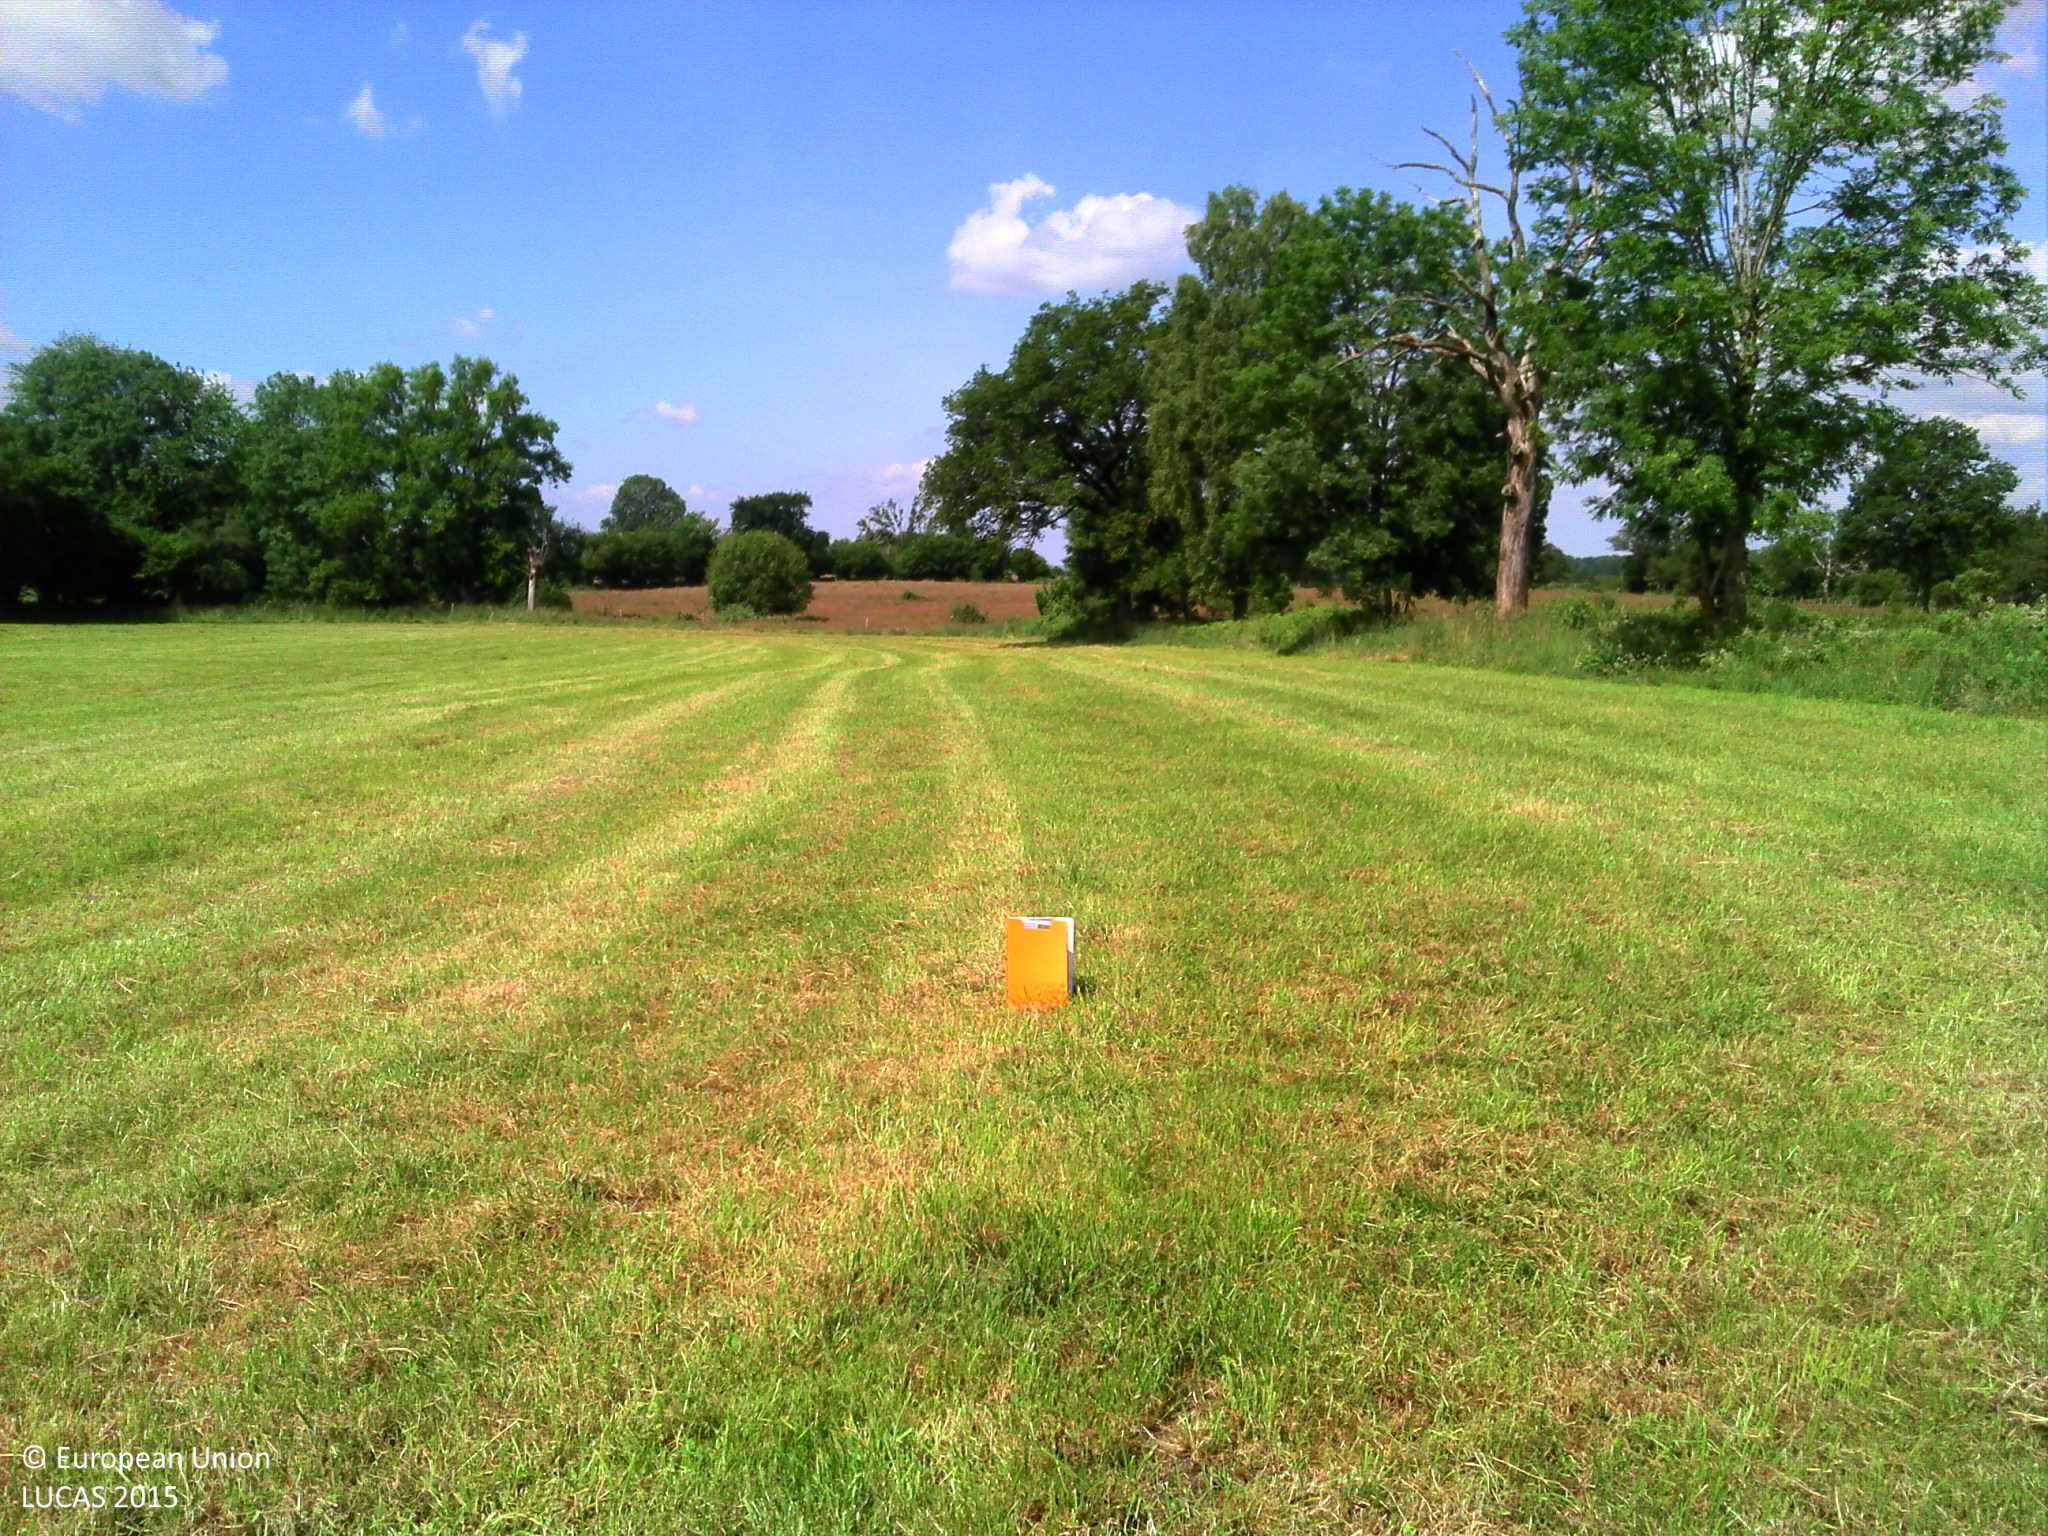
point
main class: Grassland
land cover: Grassland without tree/shrub cover
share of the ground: > 75 %
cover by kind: herbaceous plants 100 %
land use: Agriculture (excluding fallow land and kitchen gardens)
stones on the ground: < 10 %
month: June
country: FR
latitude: 45.2799
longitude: 2.3371
